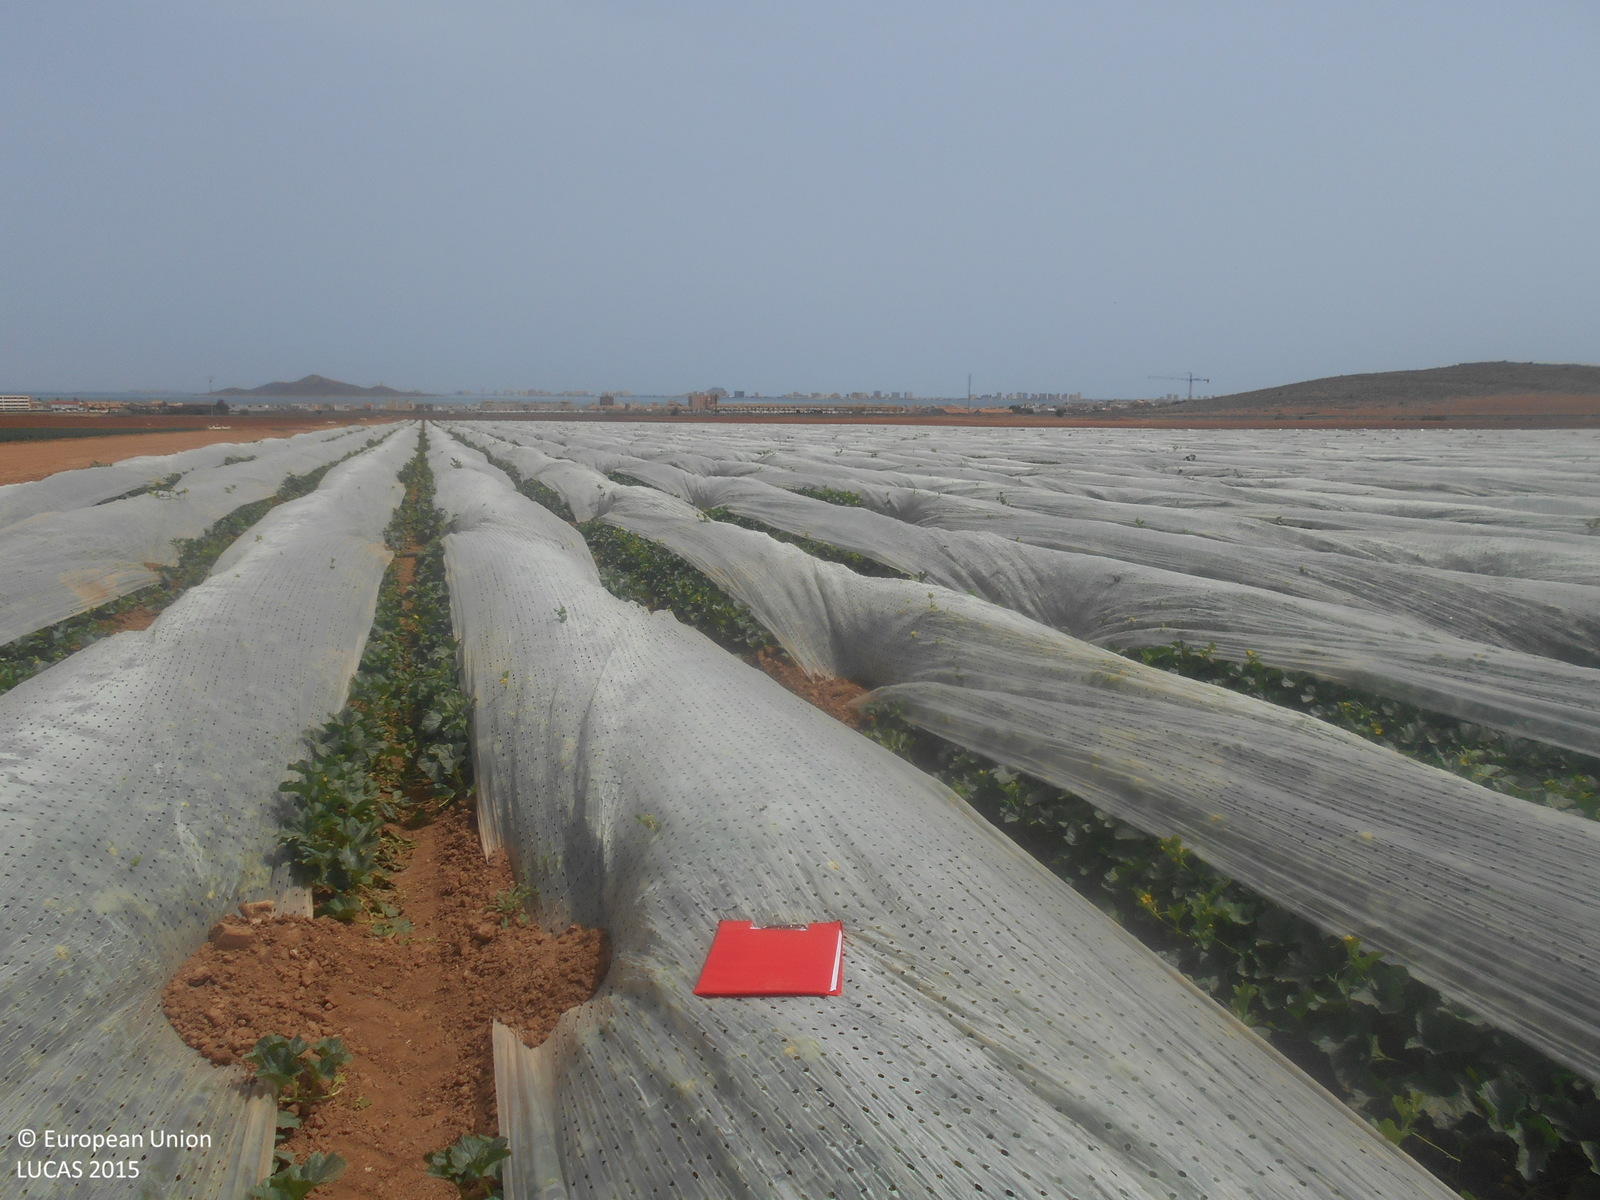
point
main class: Cropland
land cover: Other fresh vegetables
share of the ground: > 75 %
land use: Agriculture (excluding fallow land and kitchen gardens)
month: May
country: ES
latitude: 37.6423
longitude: -0.8014
